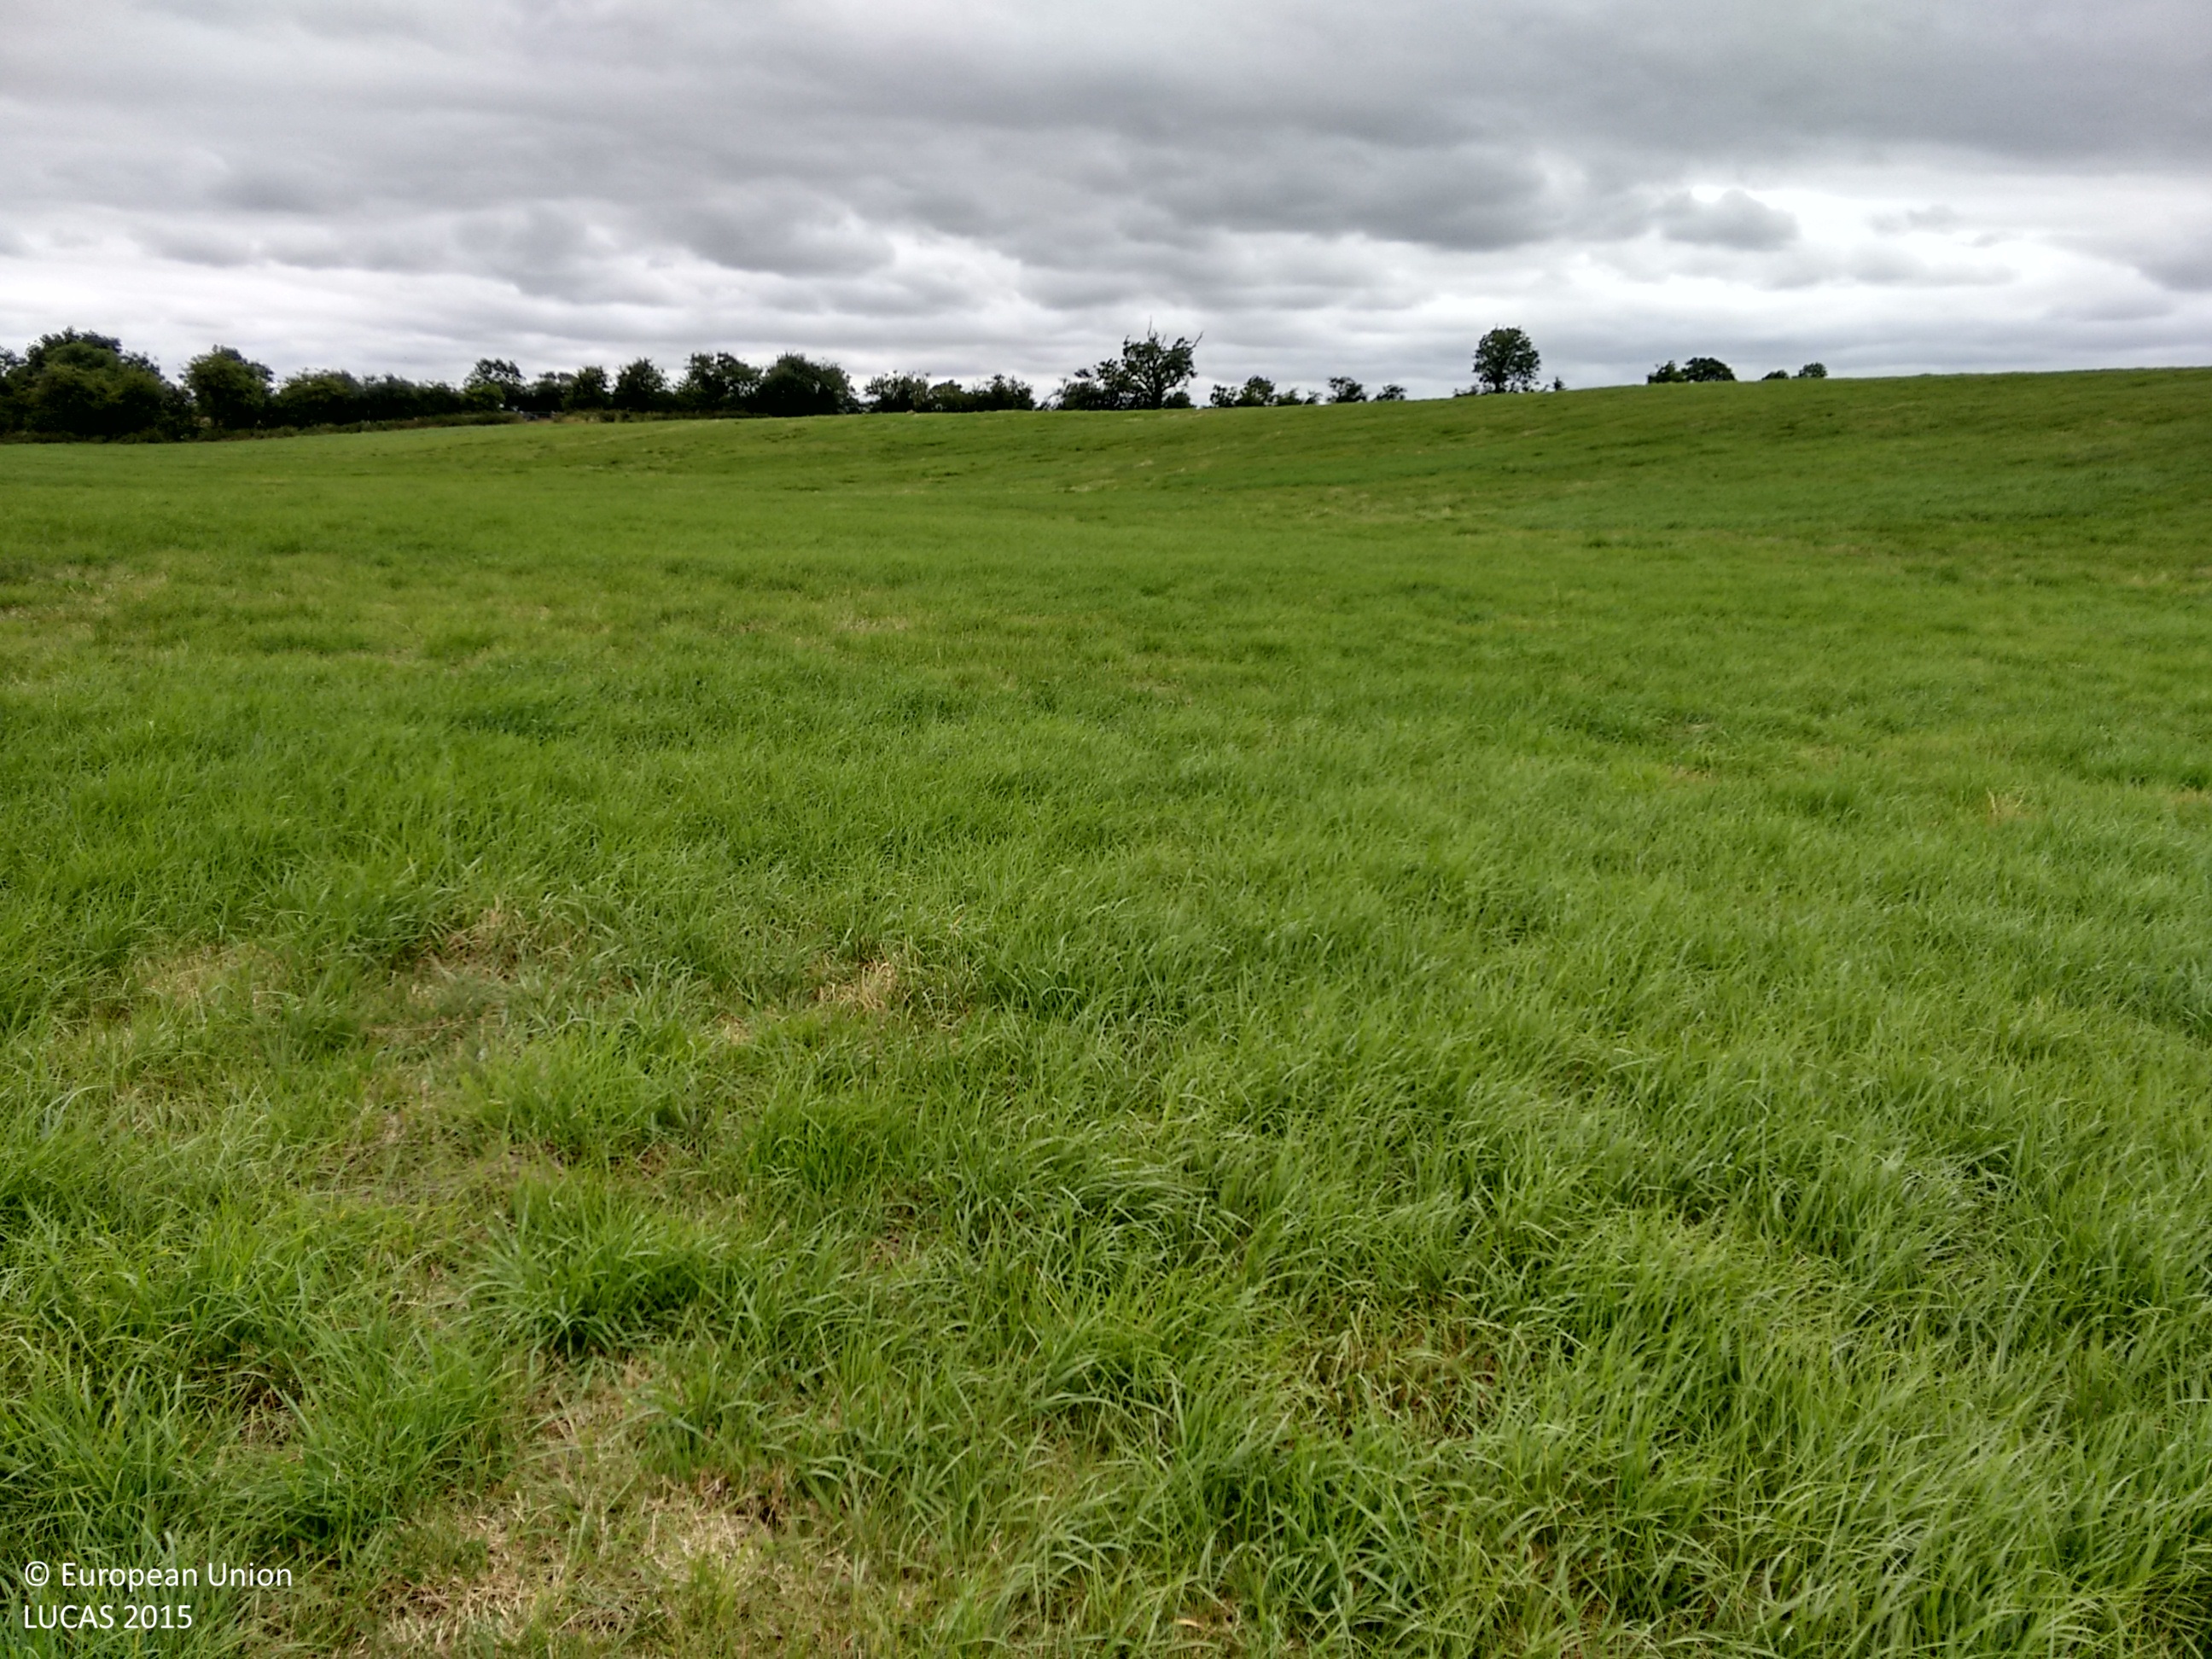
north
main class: Grassland
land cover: Grassland without tree/shrub cover
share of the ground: > 75 %
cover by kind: herbaceous plants 100 %
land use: Agriculture (excluding fallow land and kitchen gardens)
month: July
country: GB
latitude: 52.8416
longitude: -0.8351
